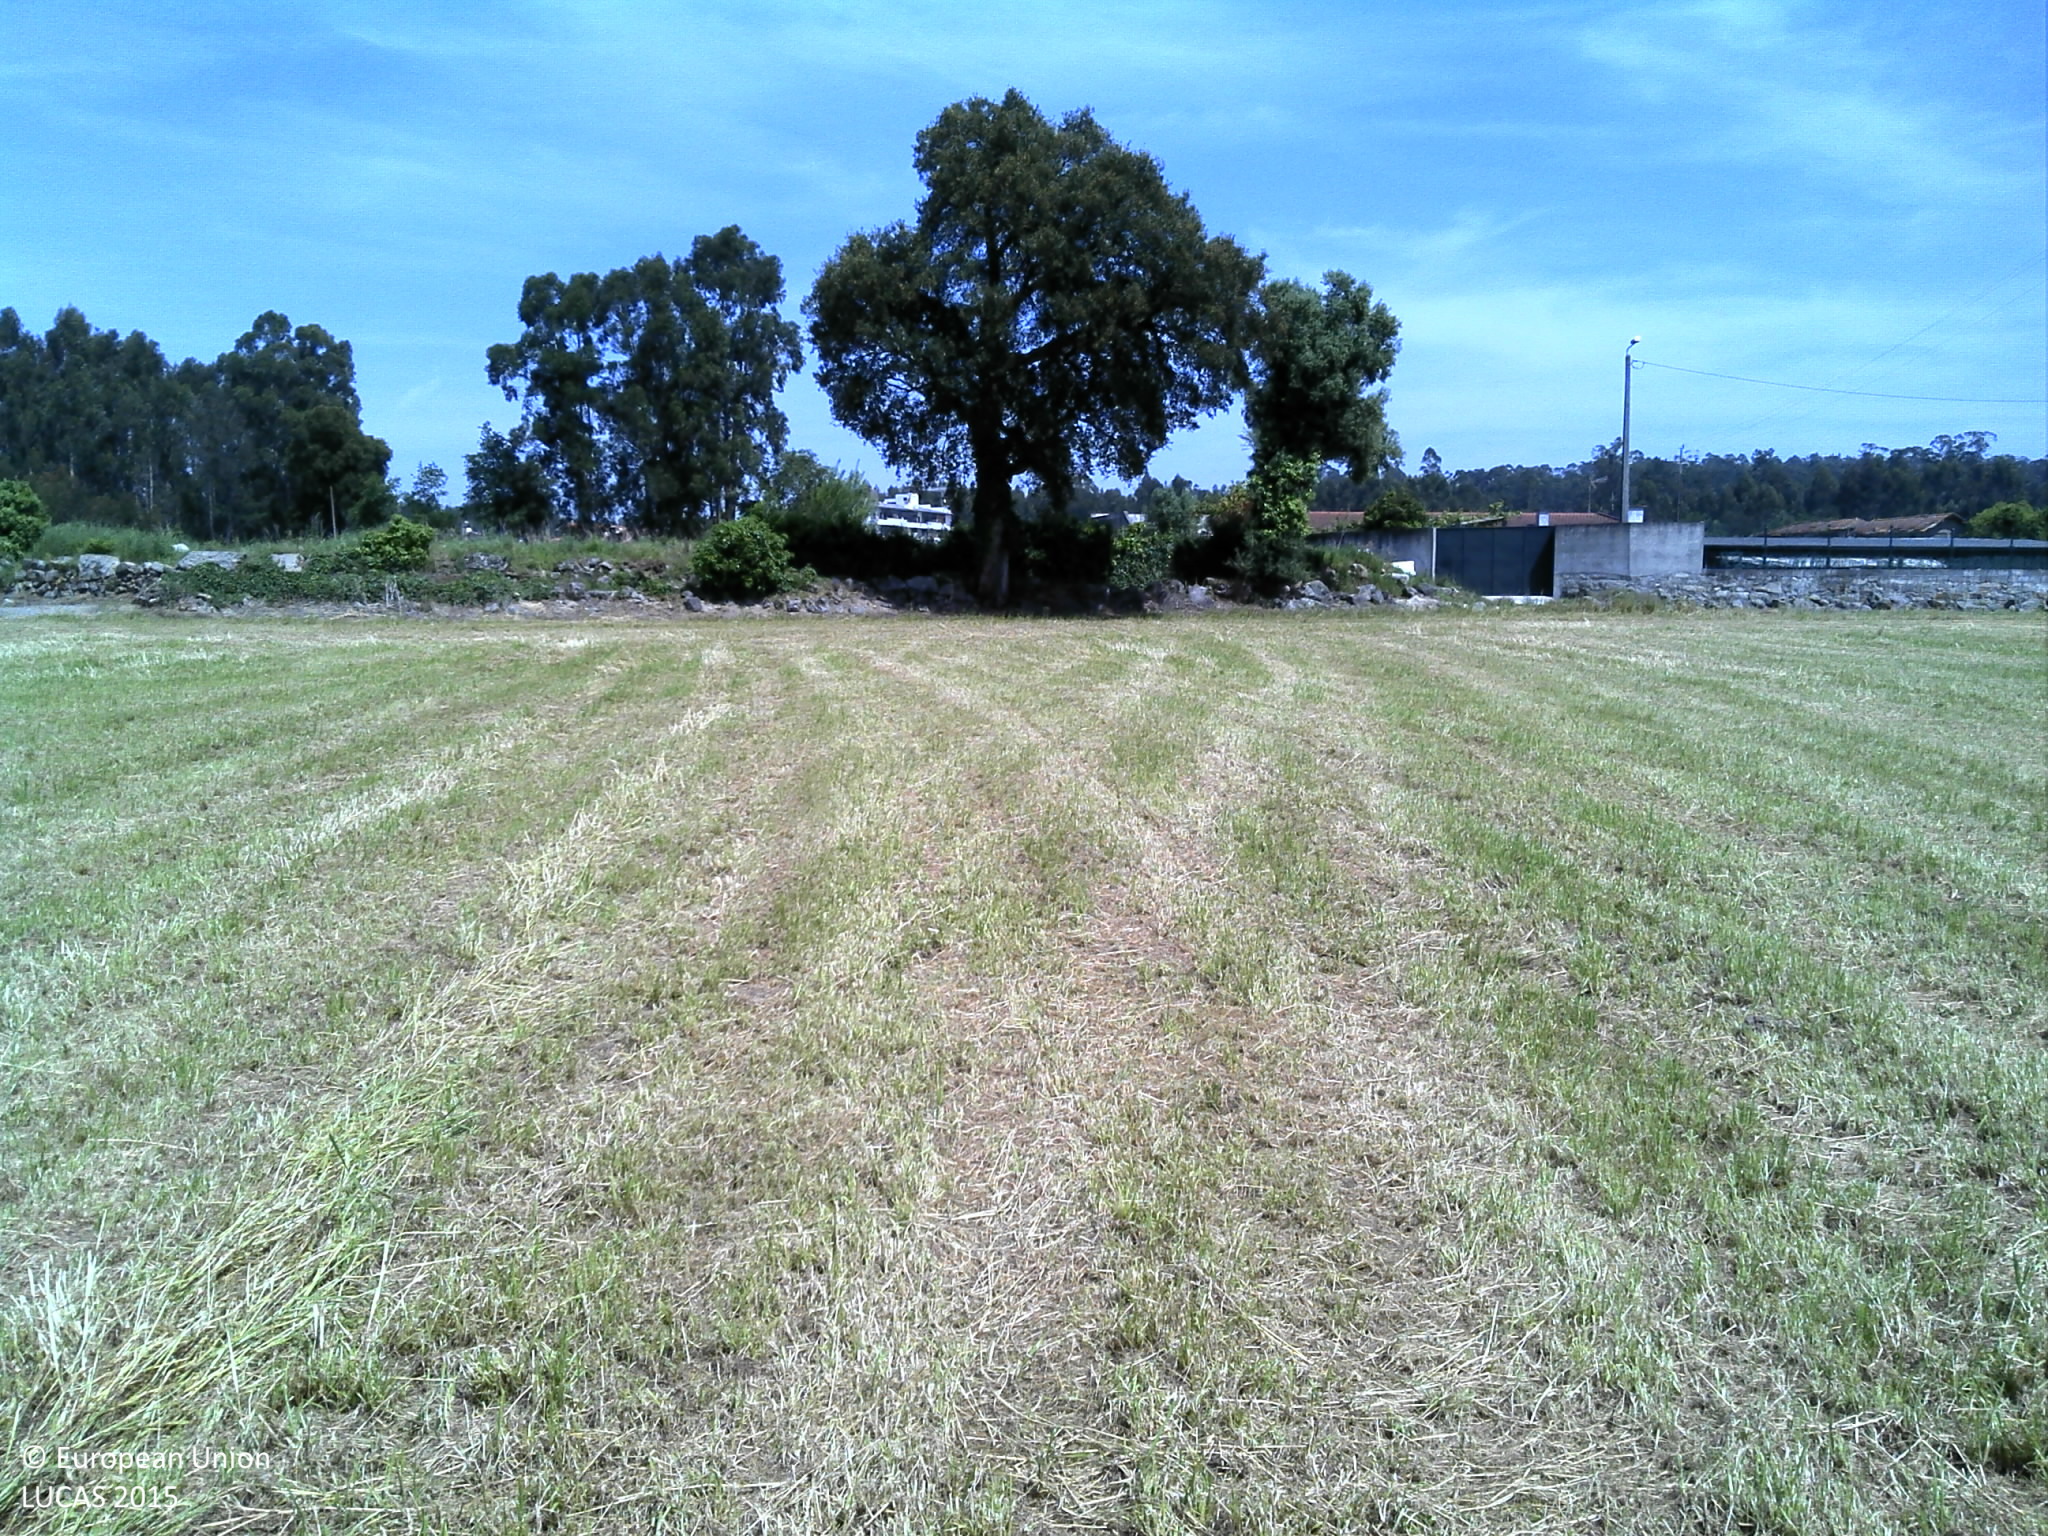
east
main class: Cropland
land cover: Temporary grasslands
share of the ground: > 75 %
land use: Agriculture (excluding fallow land and kitchen gardens)
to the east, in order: Temporary grasslands; Single bushes/trees; Dry stone walls; Tracks; Dry stone walls; Spontaneously vegetated surfaces; Dry stone walls; Tracks; Dry stone walls; Temporary grasslands
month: May
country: PT
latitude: 41.2476
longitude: -8.5906
